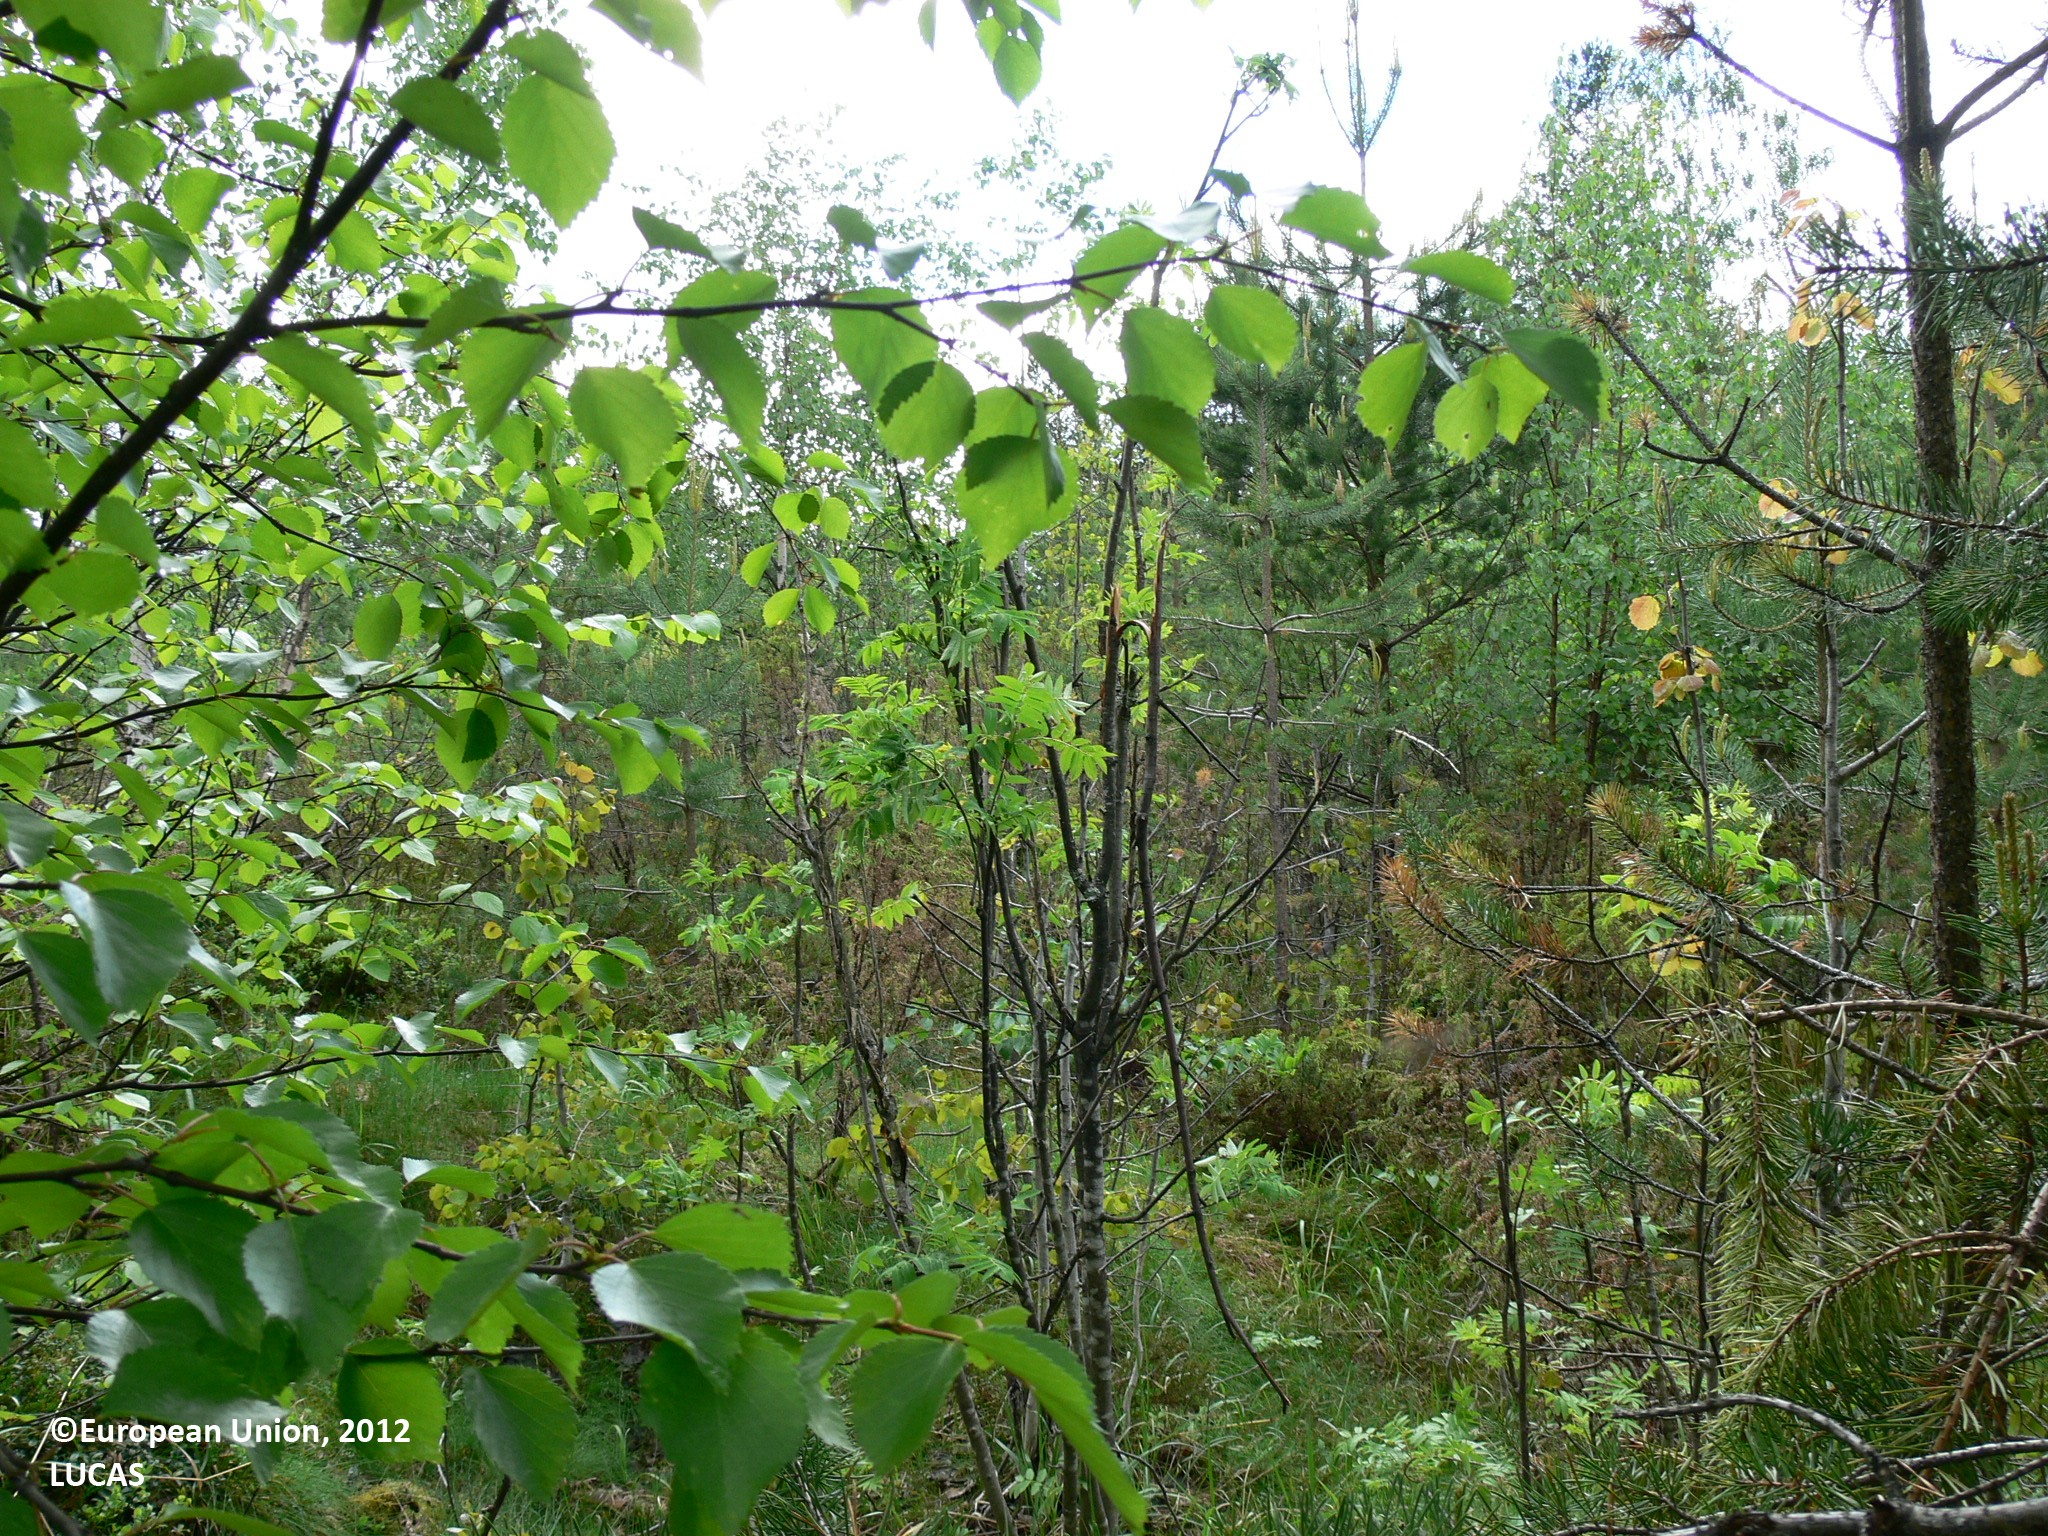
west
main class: Woodland
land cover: Other mixed woodland
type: boreal forest
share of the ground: 50 - 75 %
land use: Forestry
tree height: > 5 m
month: June
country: FI
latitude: 62.4256
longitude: 30.2768
